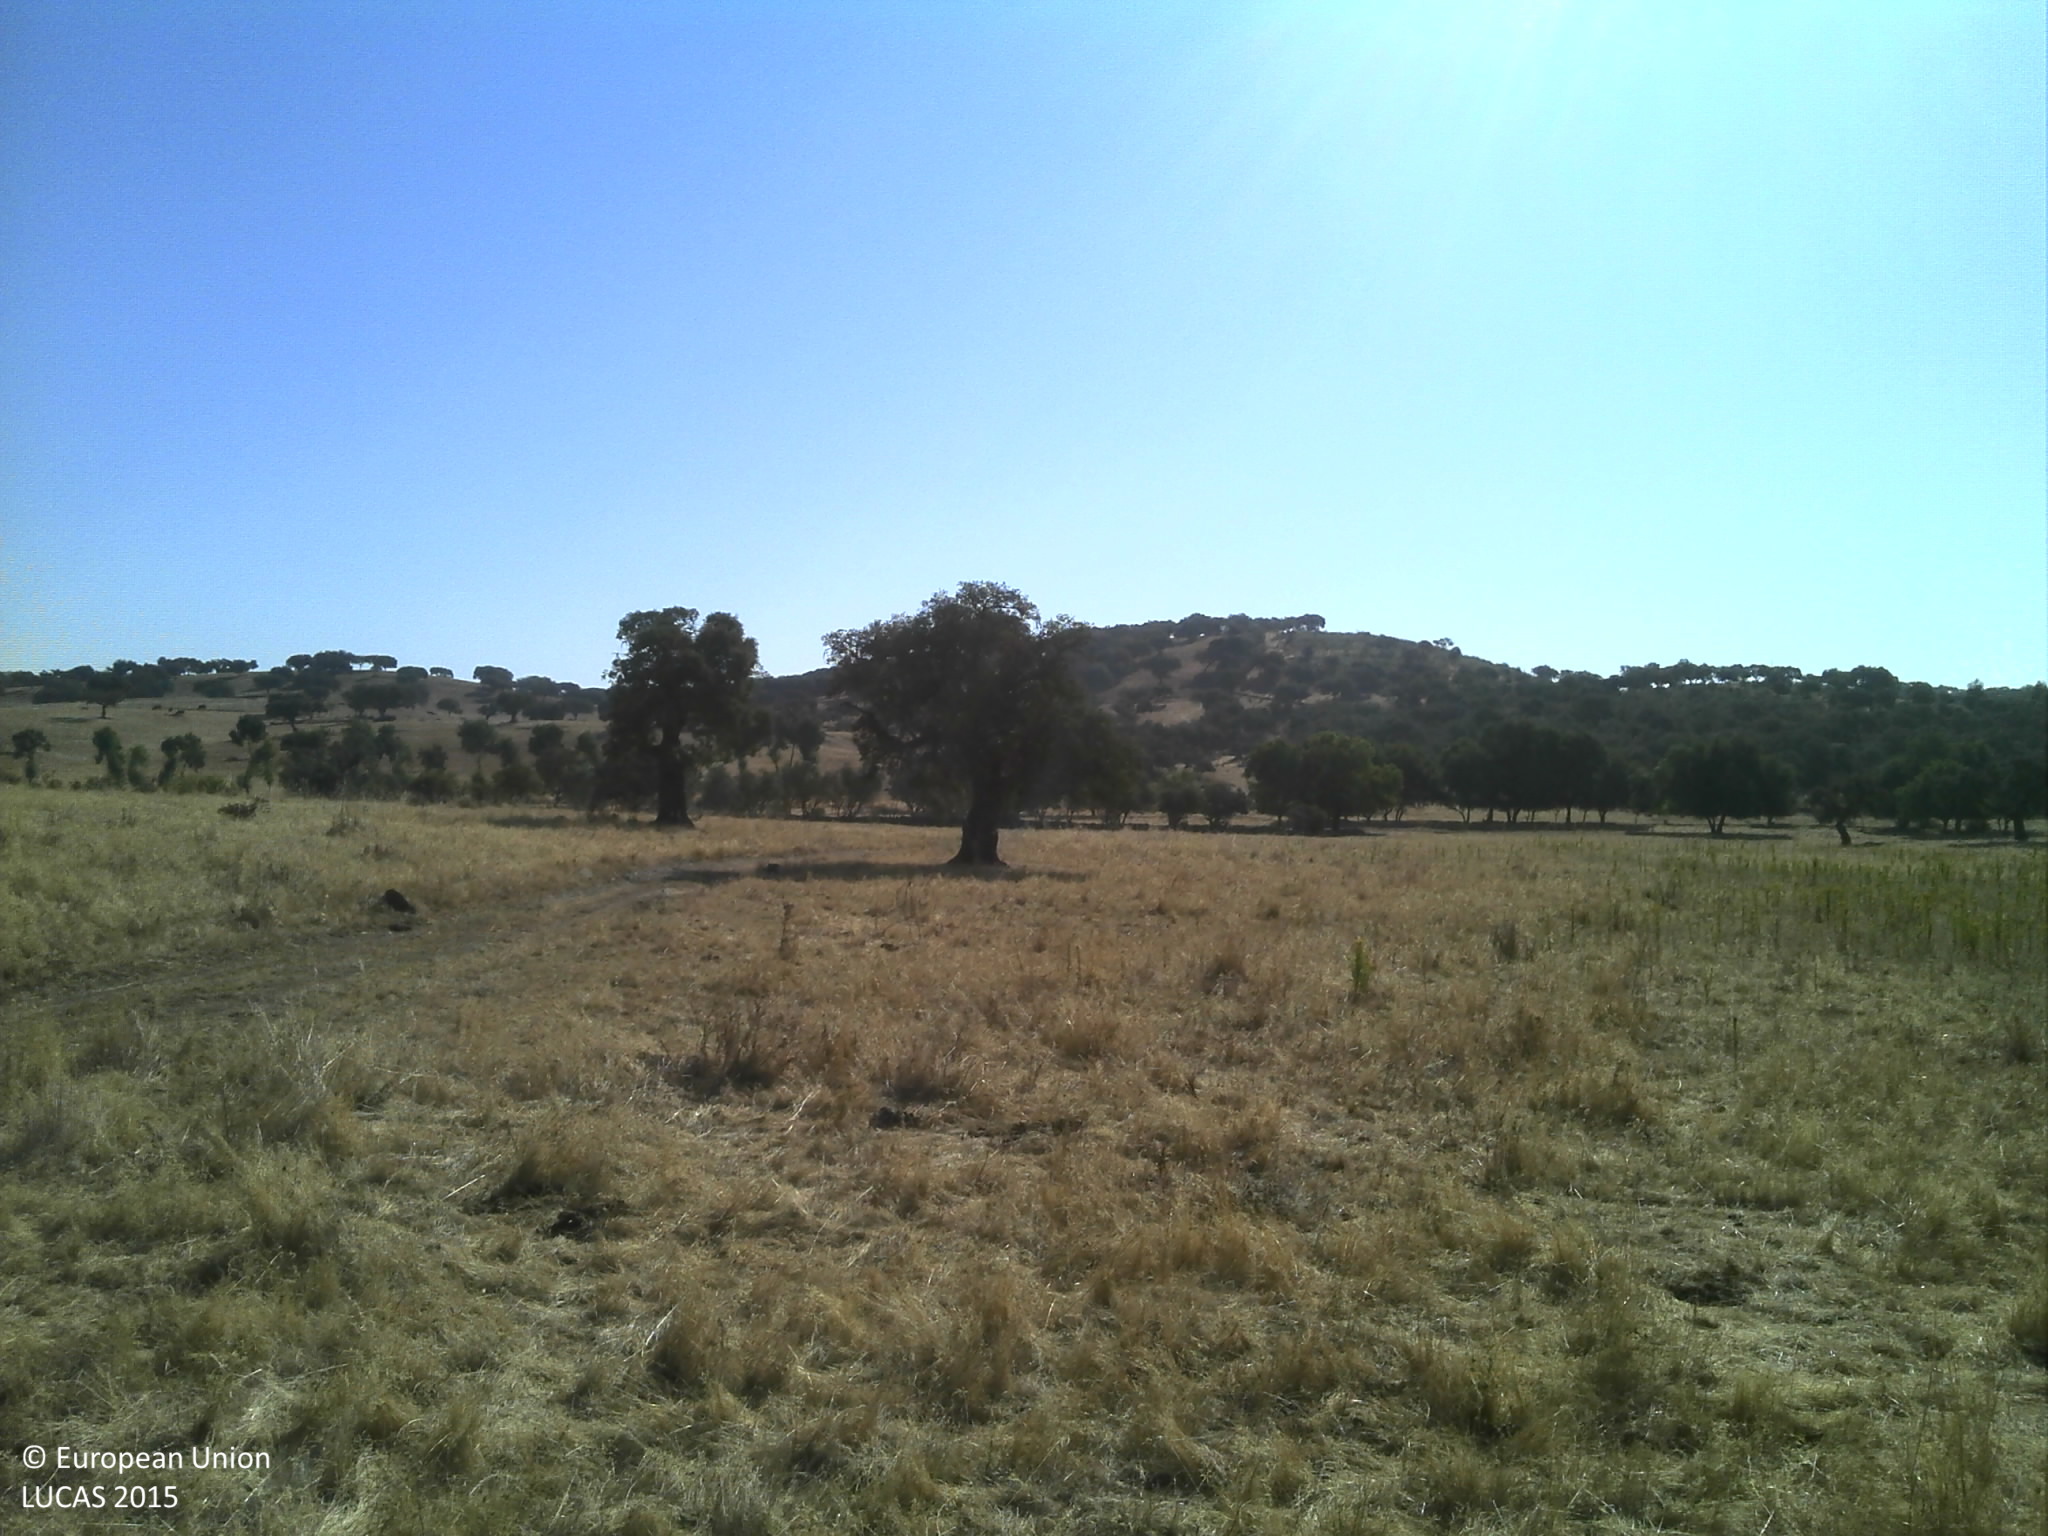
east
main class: Grassland
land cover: Grassland without tree/shrub cover
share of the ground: 50 - 75 %
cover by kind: herbaceous plants 60 %, unconsolidated bare surface 40 %
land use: Agriculture (excluding fallow land and kitchen gardens)
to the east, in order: Grassland without tree/shrub cover; Grassland with sparse tree/shrub cover; Grassland without tree/shrub cover; Broadleaved woodland
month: July
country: PT
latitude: 38.6619
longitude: -7.2998
